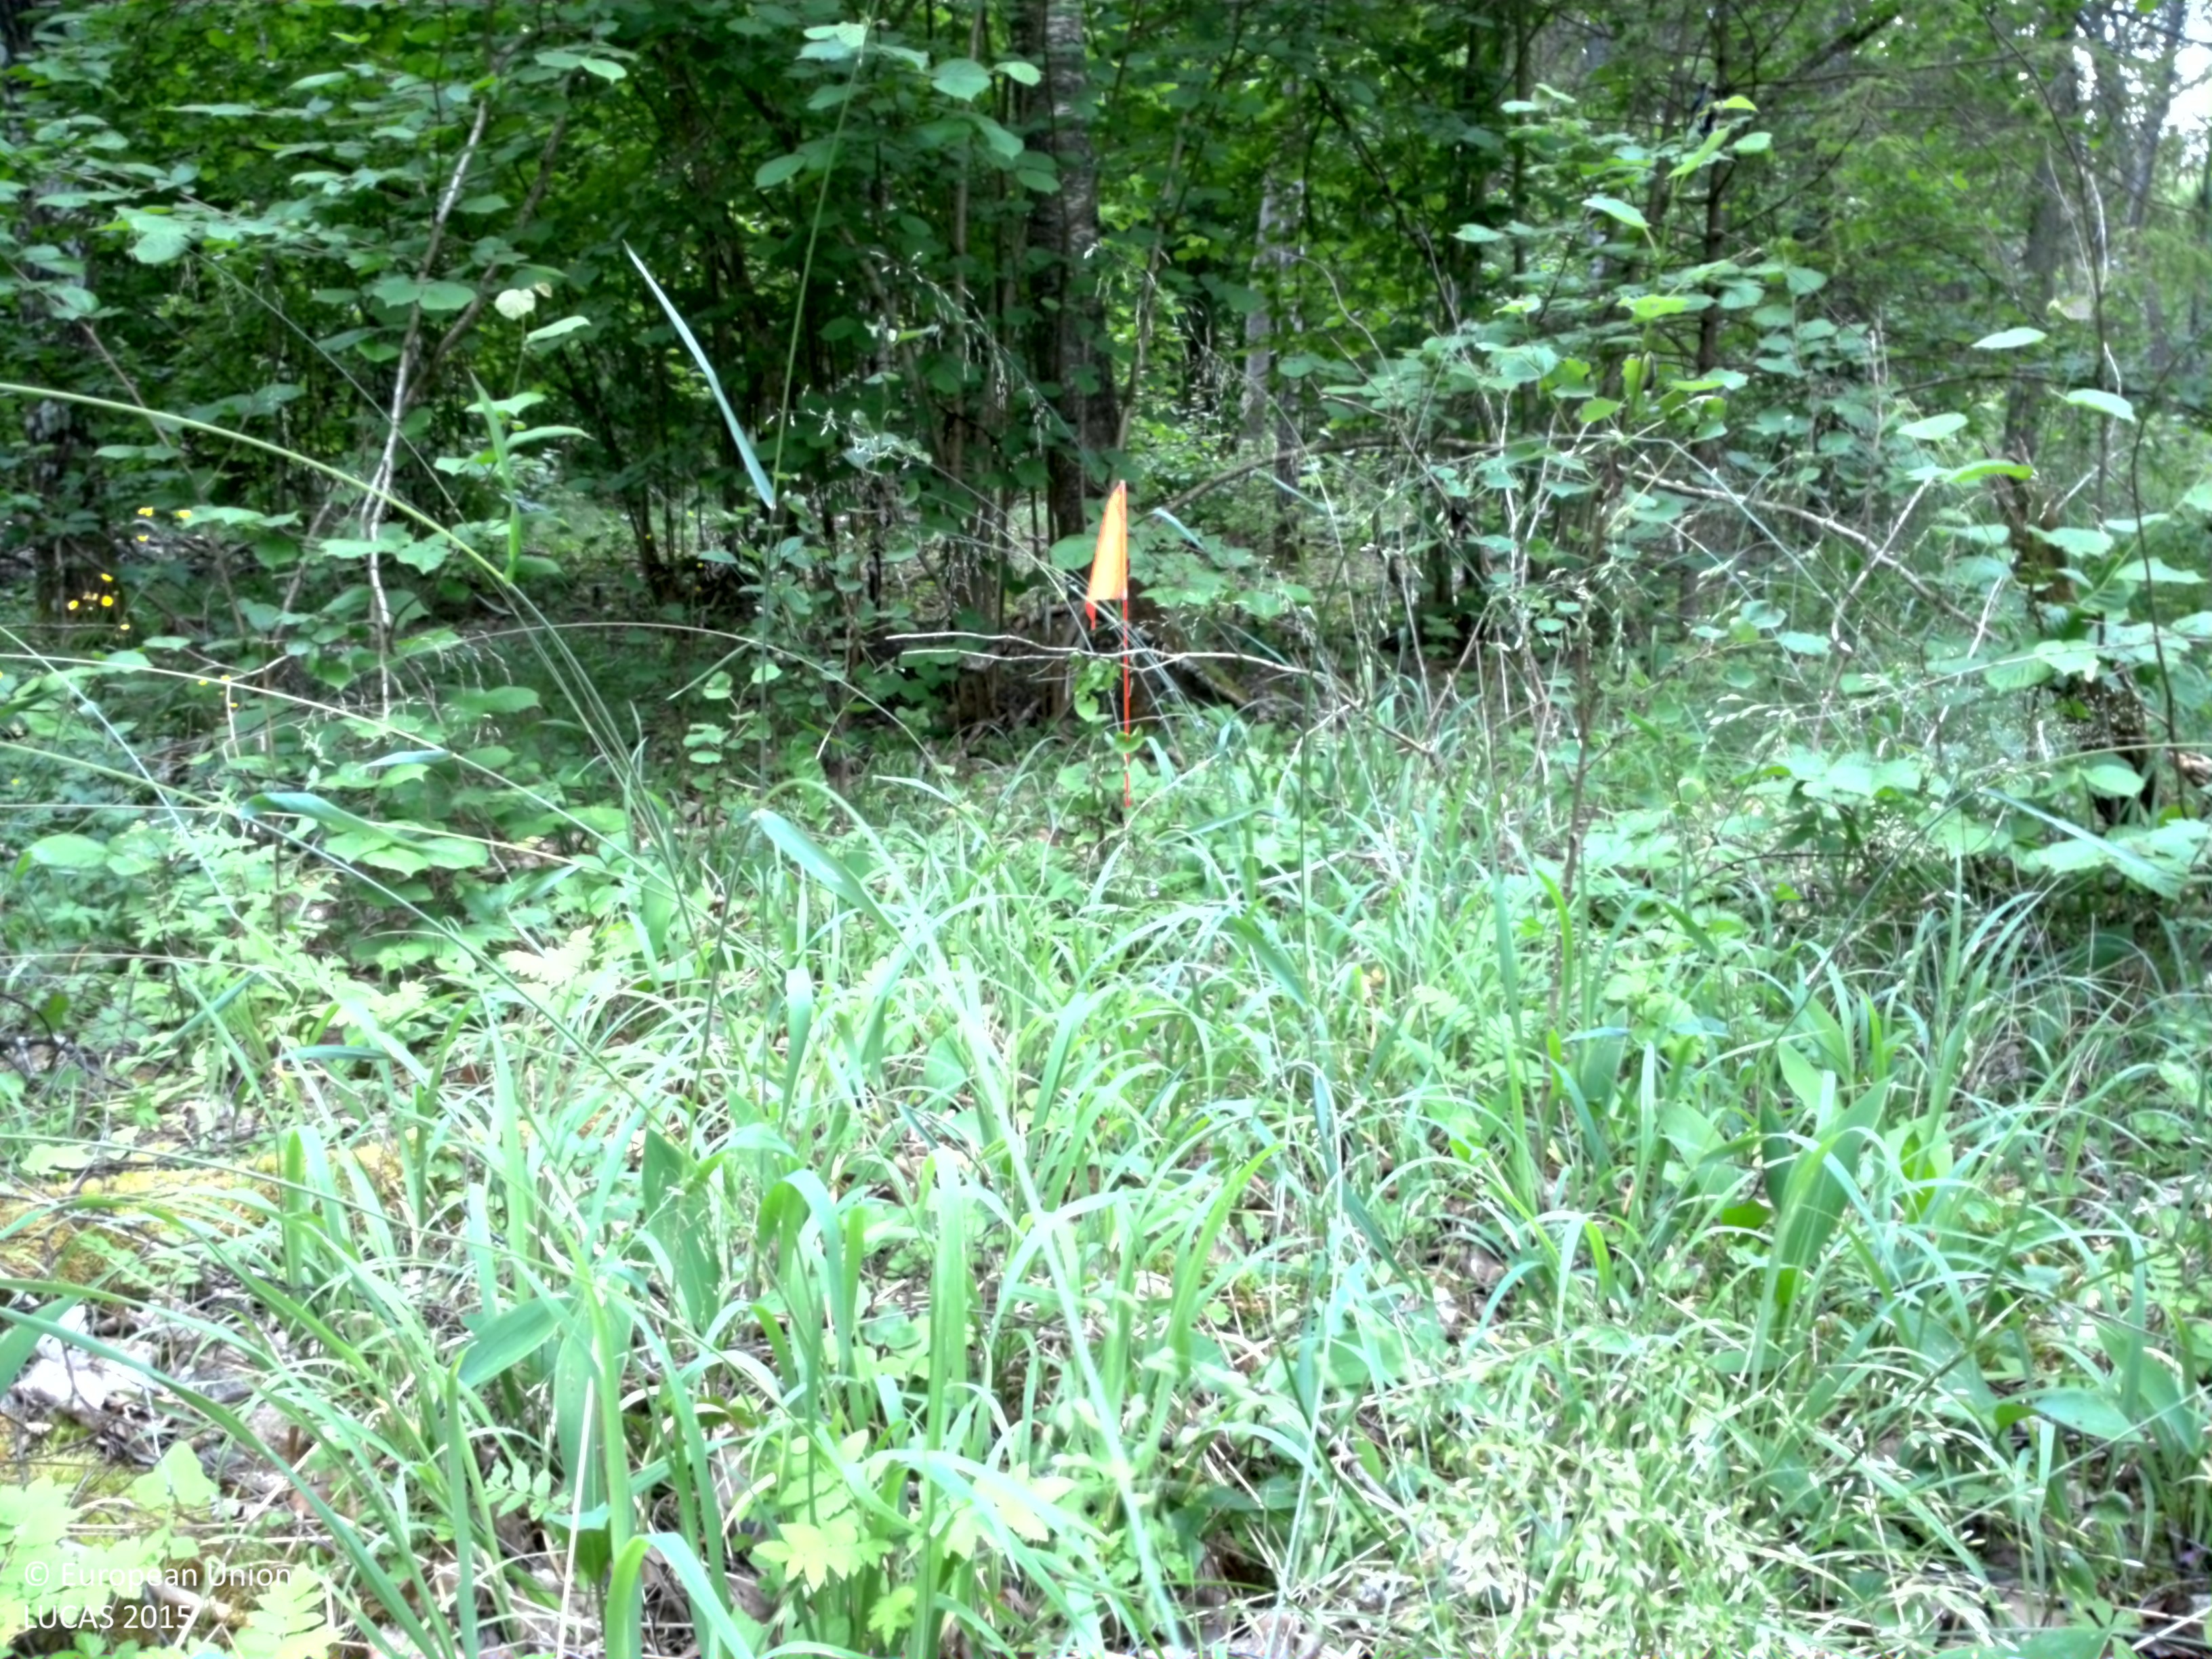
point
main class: Woodland
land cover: Broadleaved woodland
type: hemiboreal forest and nemoral coniferous forest and mixed broadleaved-coniferous forest
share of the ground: > 75 %
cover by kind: broadleaved forest trees 70 %, herbaceous plants 25 %, coniferous forest trees 5 %
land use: Forestry
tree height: > 5 m
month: July
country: SE
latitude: 59.7983
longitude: 17.5329
